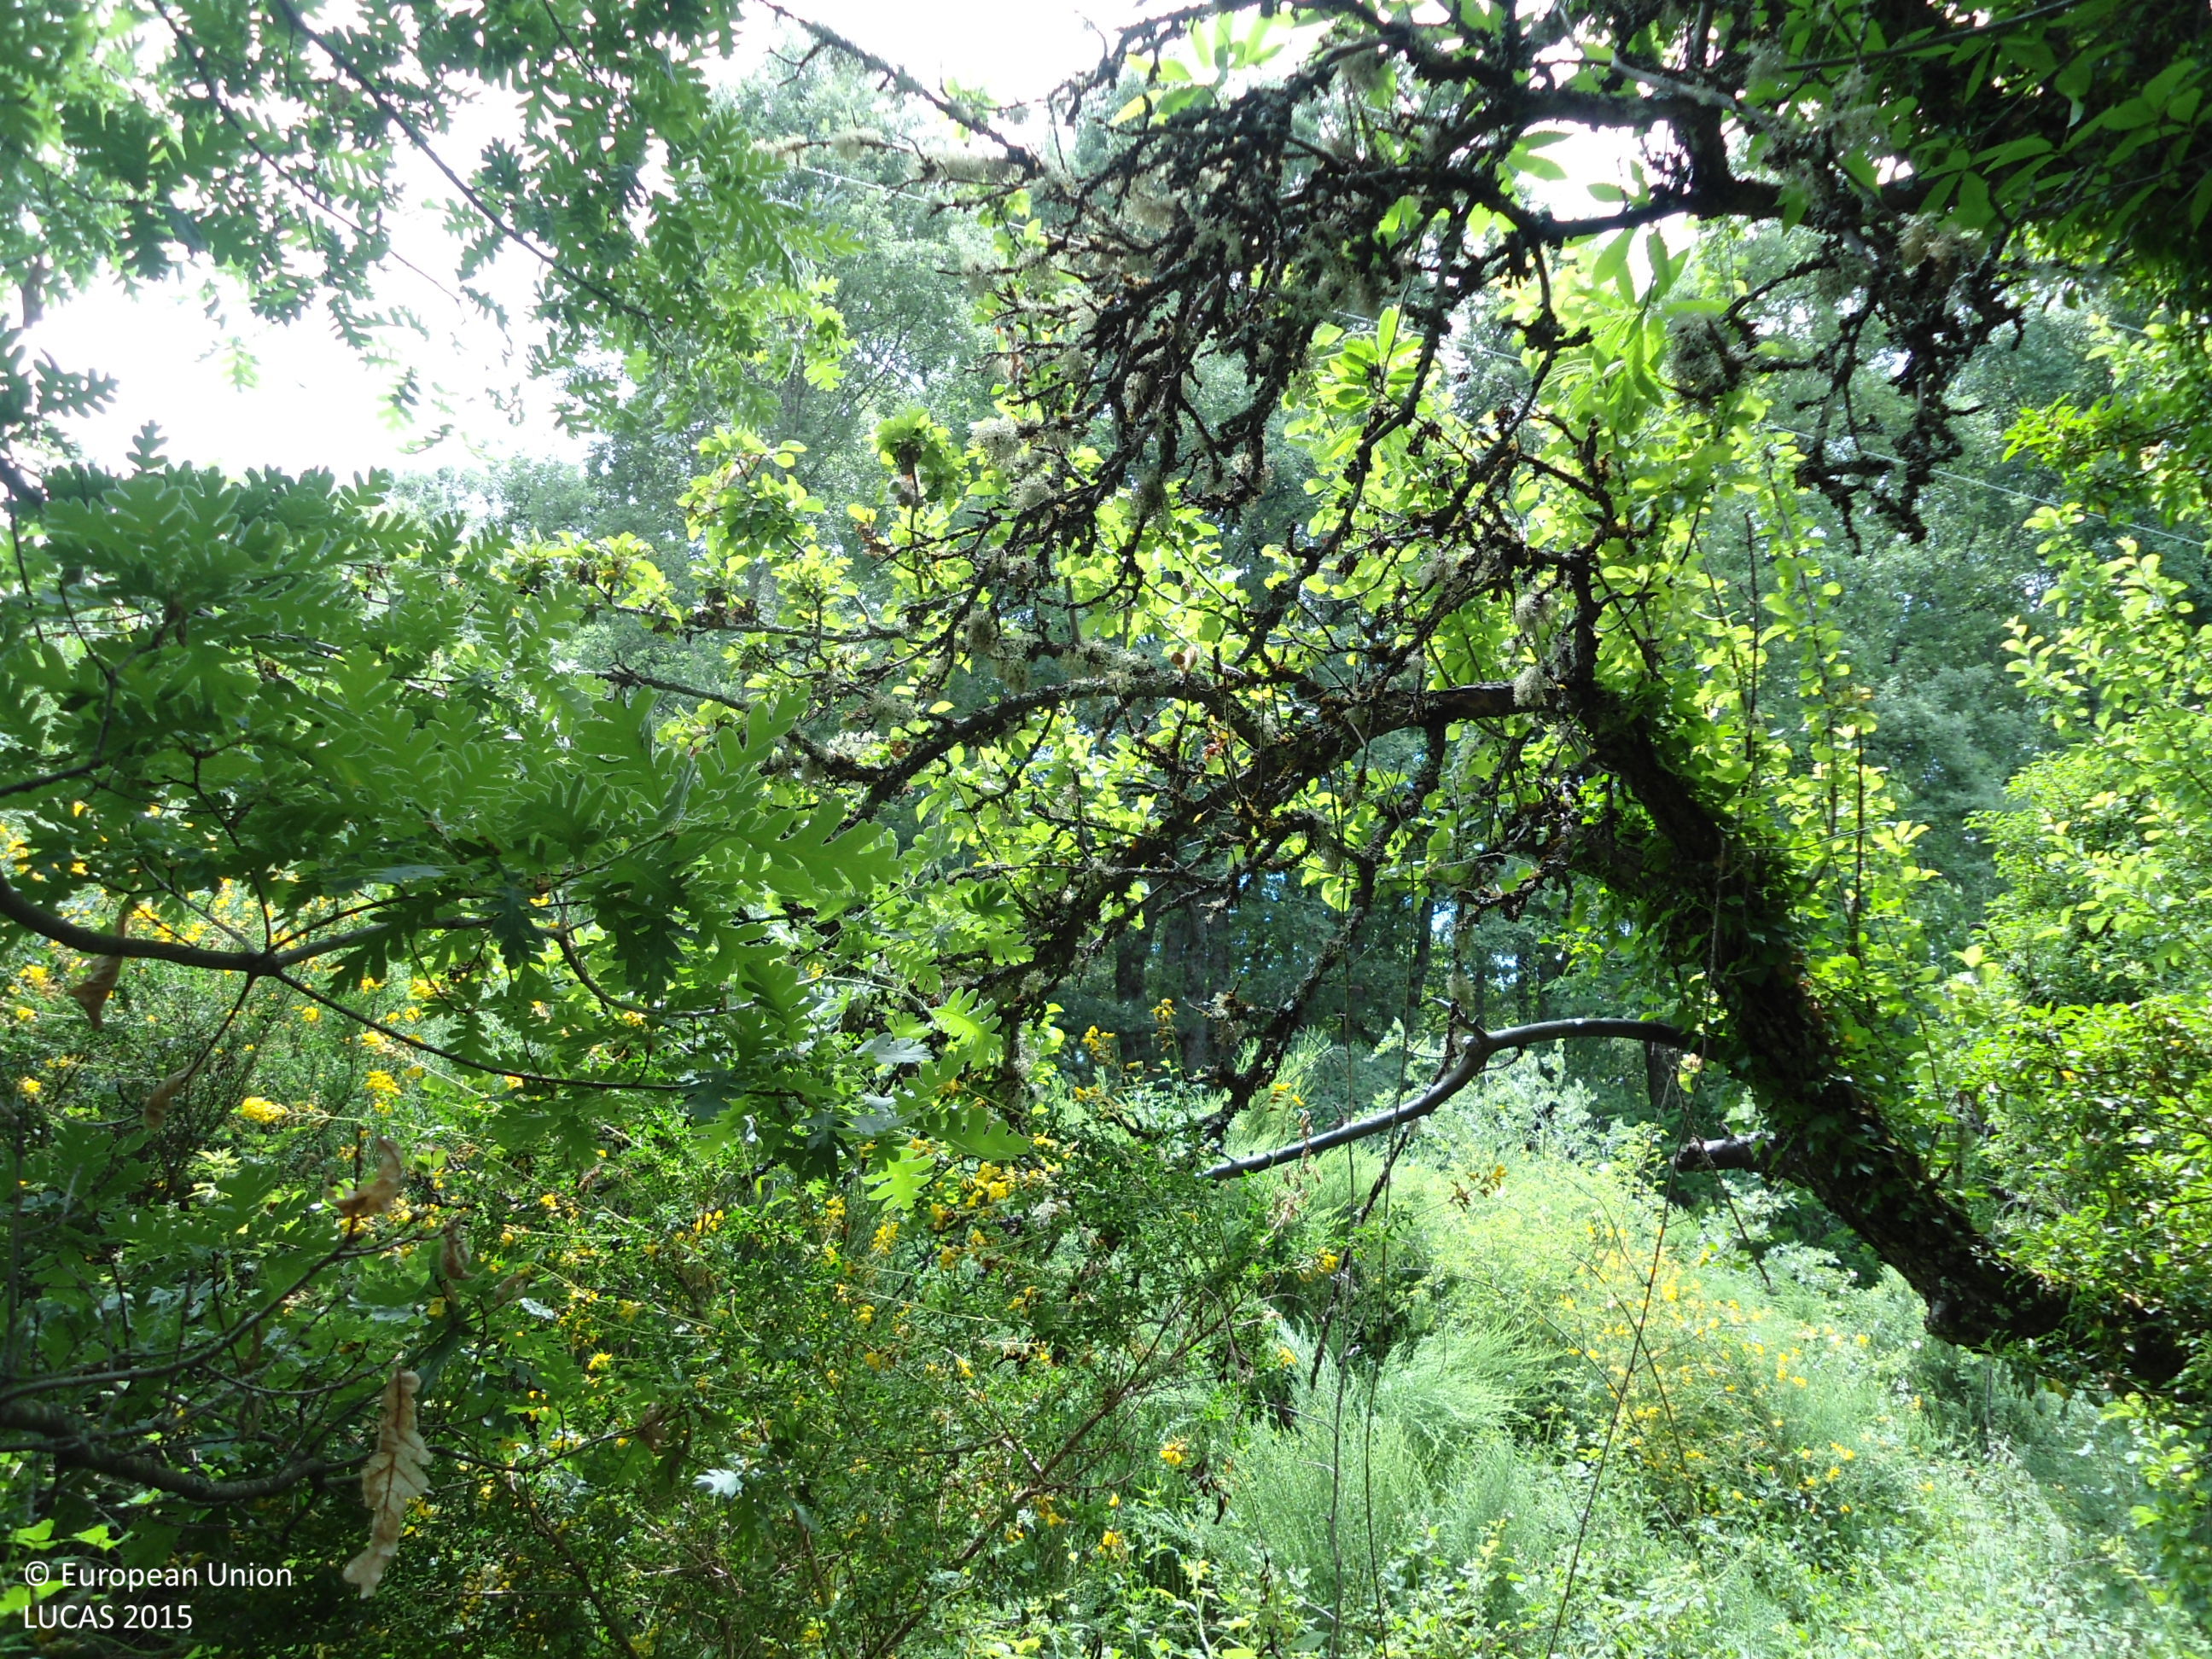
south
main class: Woodland
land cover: Broadleaved woodland
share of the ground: > 75 %
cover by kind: broadleaved forest trees 90 %, shrubs 10 %
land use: Forestry
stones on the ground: < 10 %
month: June
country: ES
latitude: 42.0978
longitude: -6.6187
